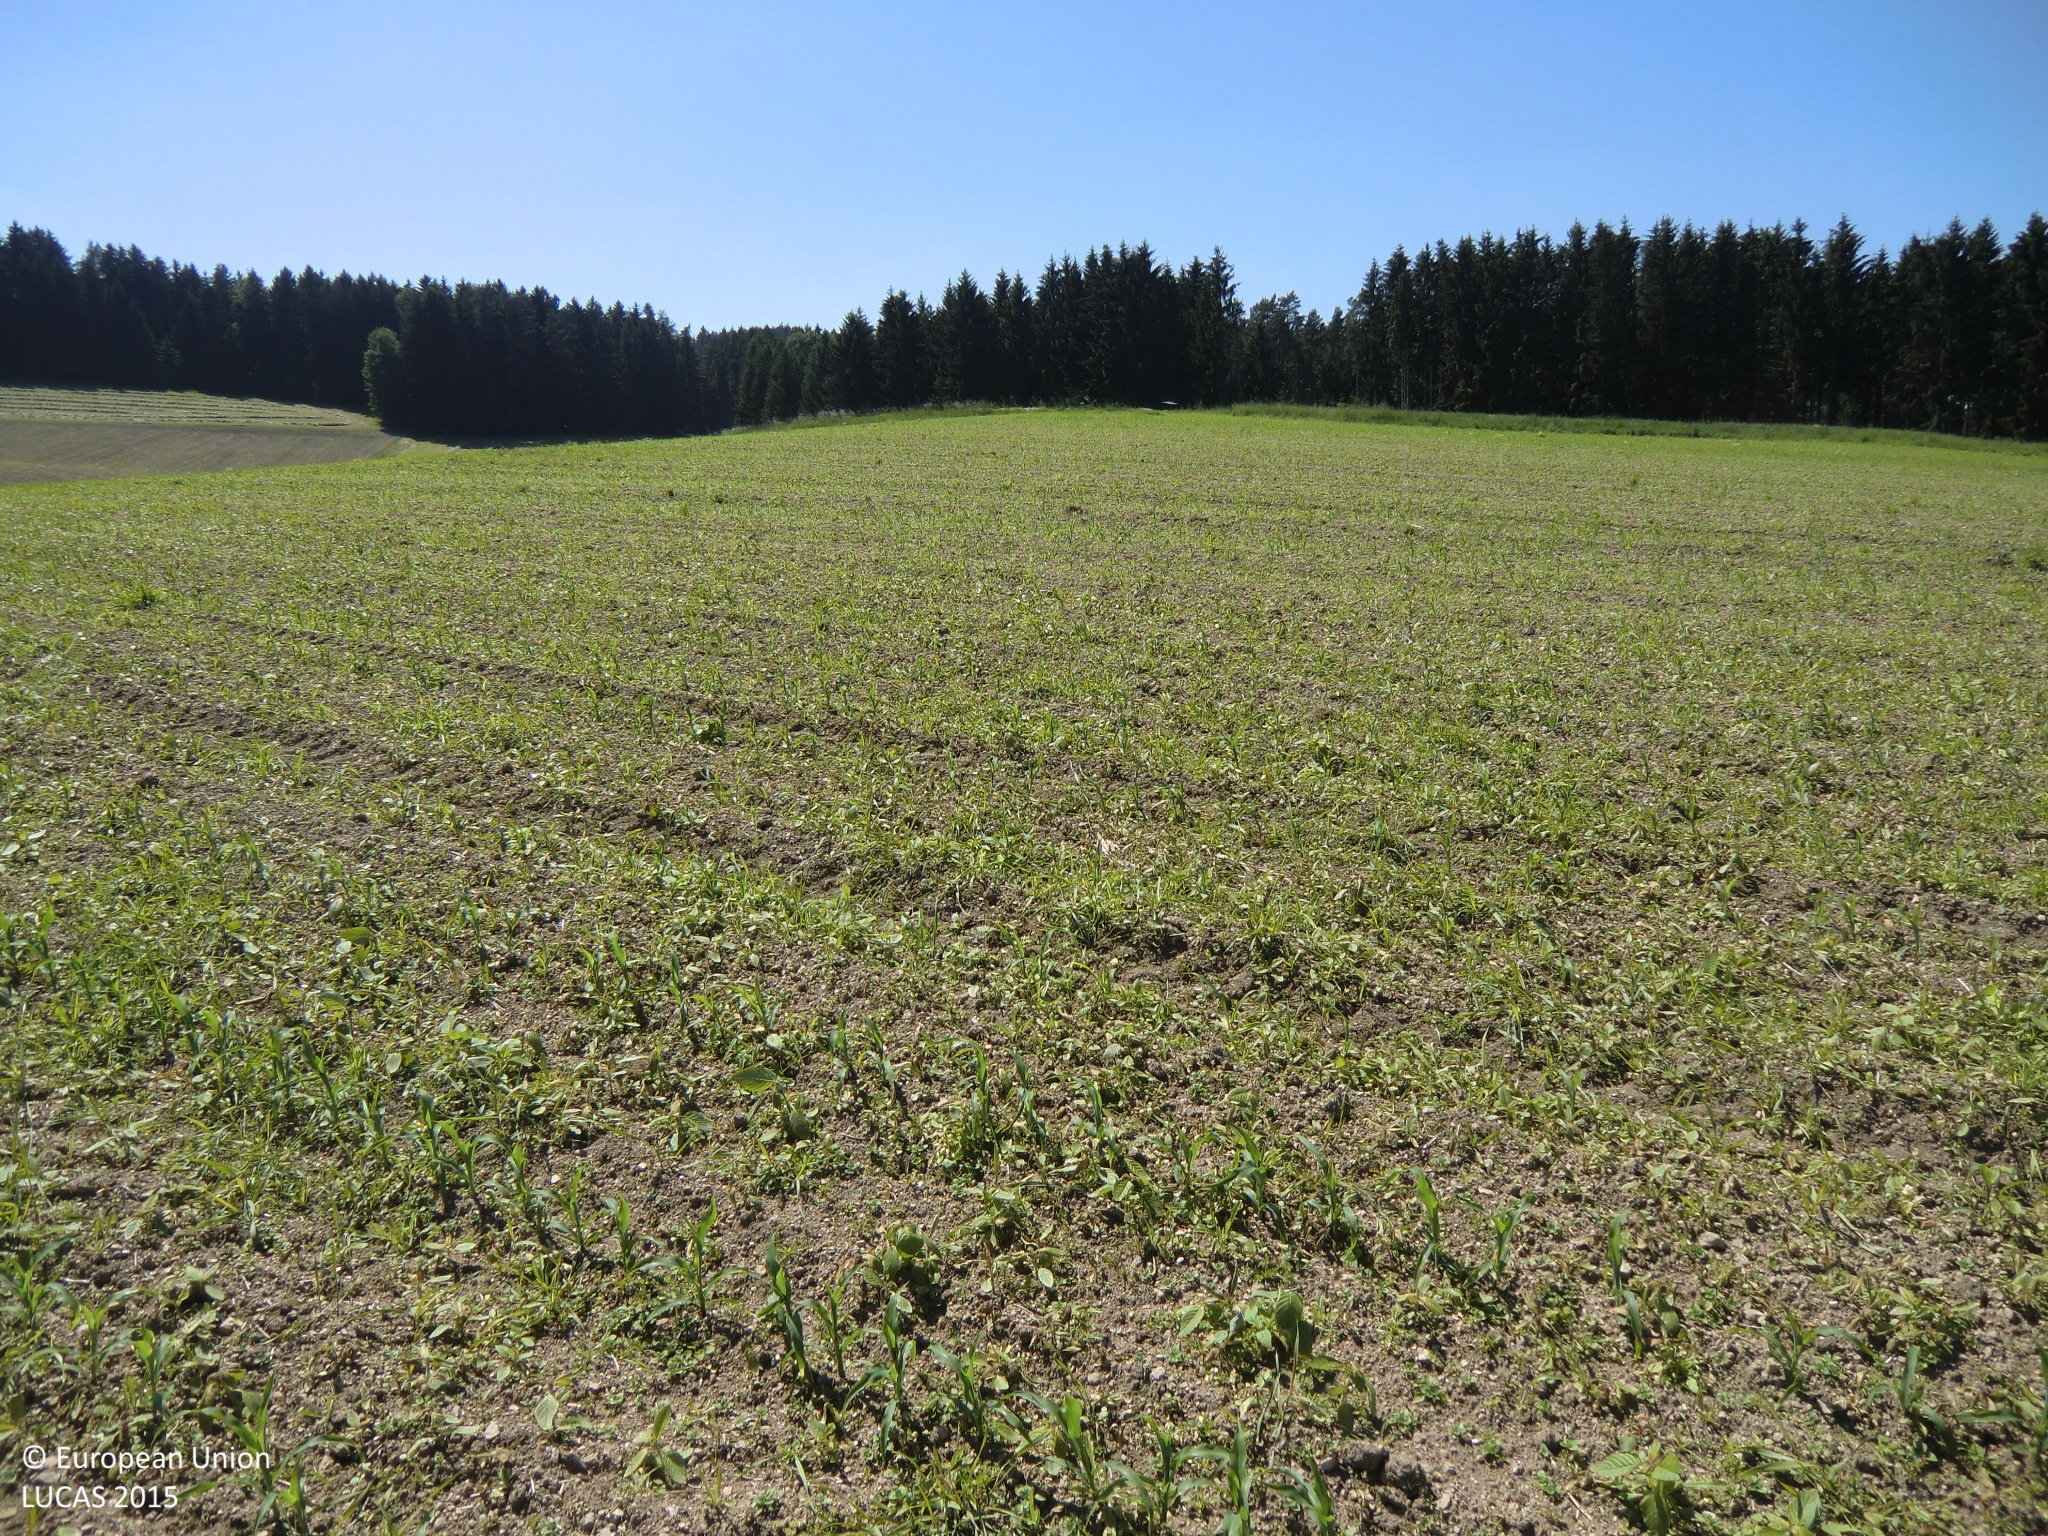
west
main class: Cropland
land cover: Maize
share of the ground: 25 - 50 %
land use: Agriculture (excluding fallow land and kitchen gardens)
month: June
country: AT
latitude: 48.5490
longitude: 14.4304
